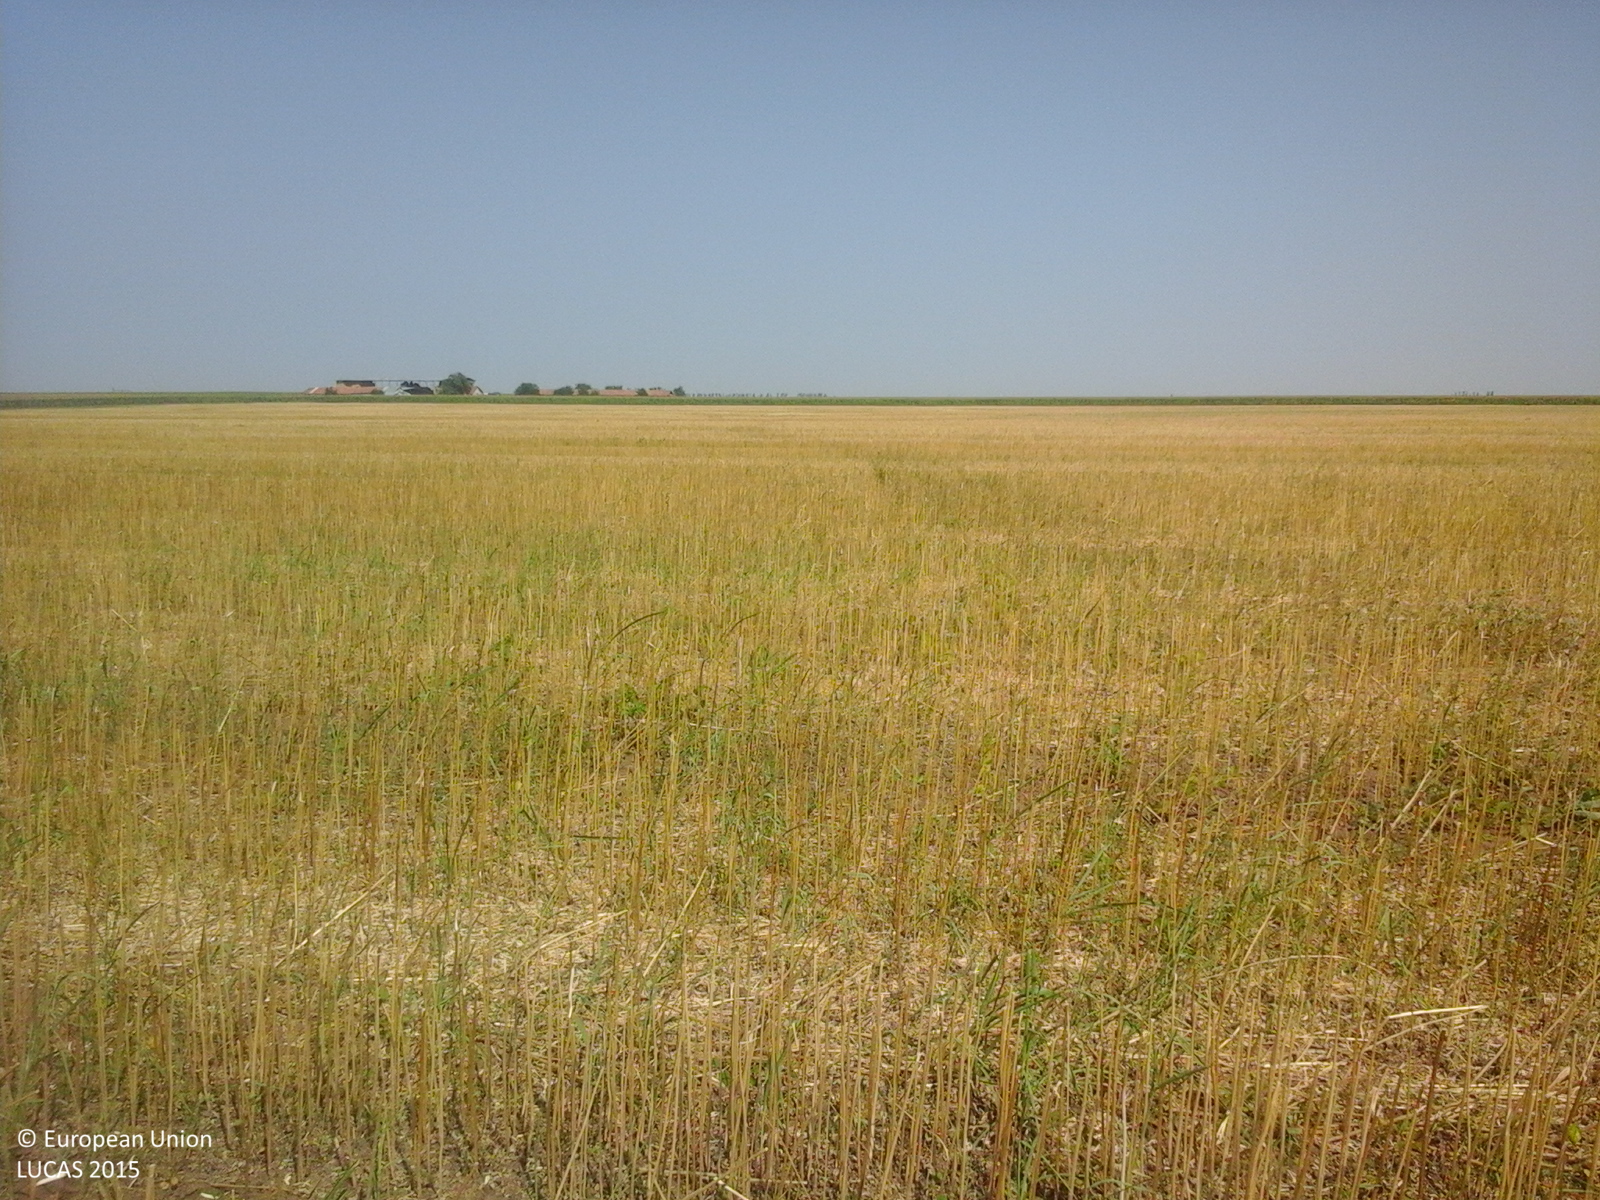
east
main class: Cropland
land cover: Rape and turnip rape
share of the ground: 25 - 50 %
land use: Agriculture (excluding fallow land and kitchen gardens)
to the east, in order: Rape and turnip rape
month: July
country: RO
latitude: 44.7462
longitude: 27.1745
